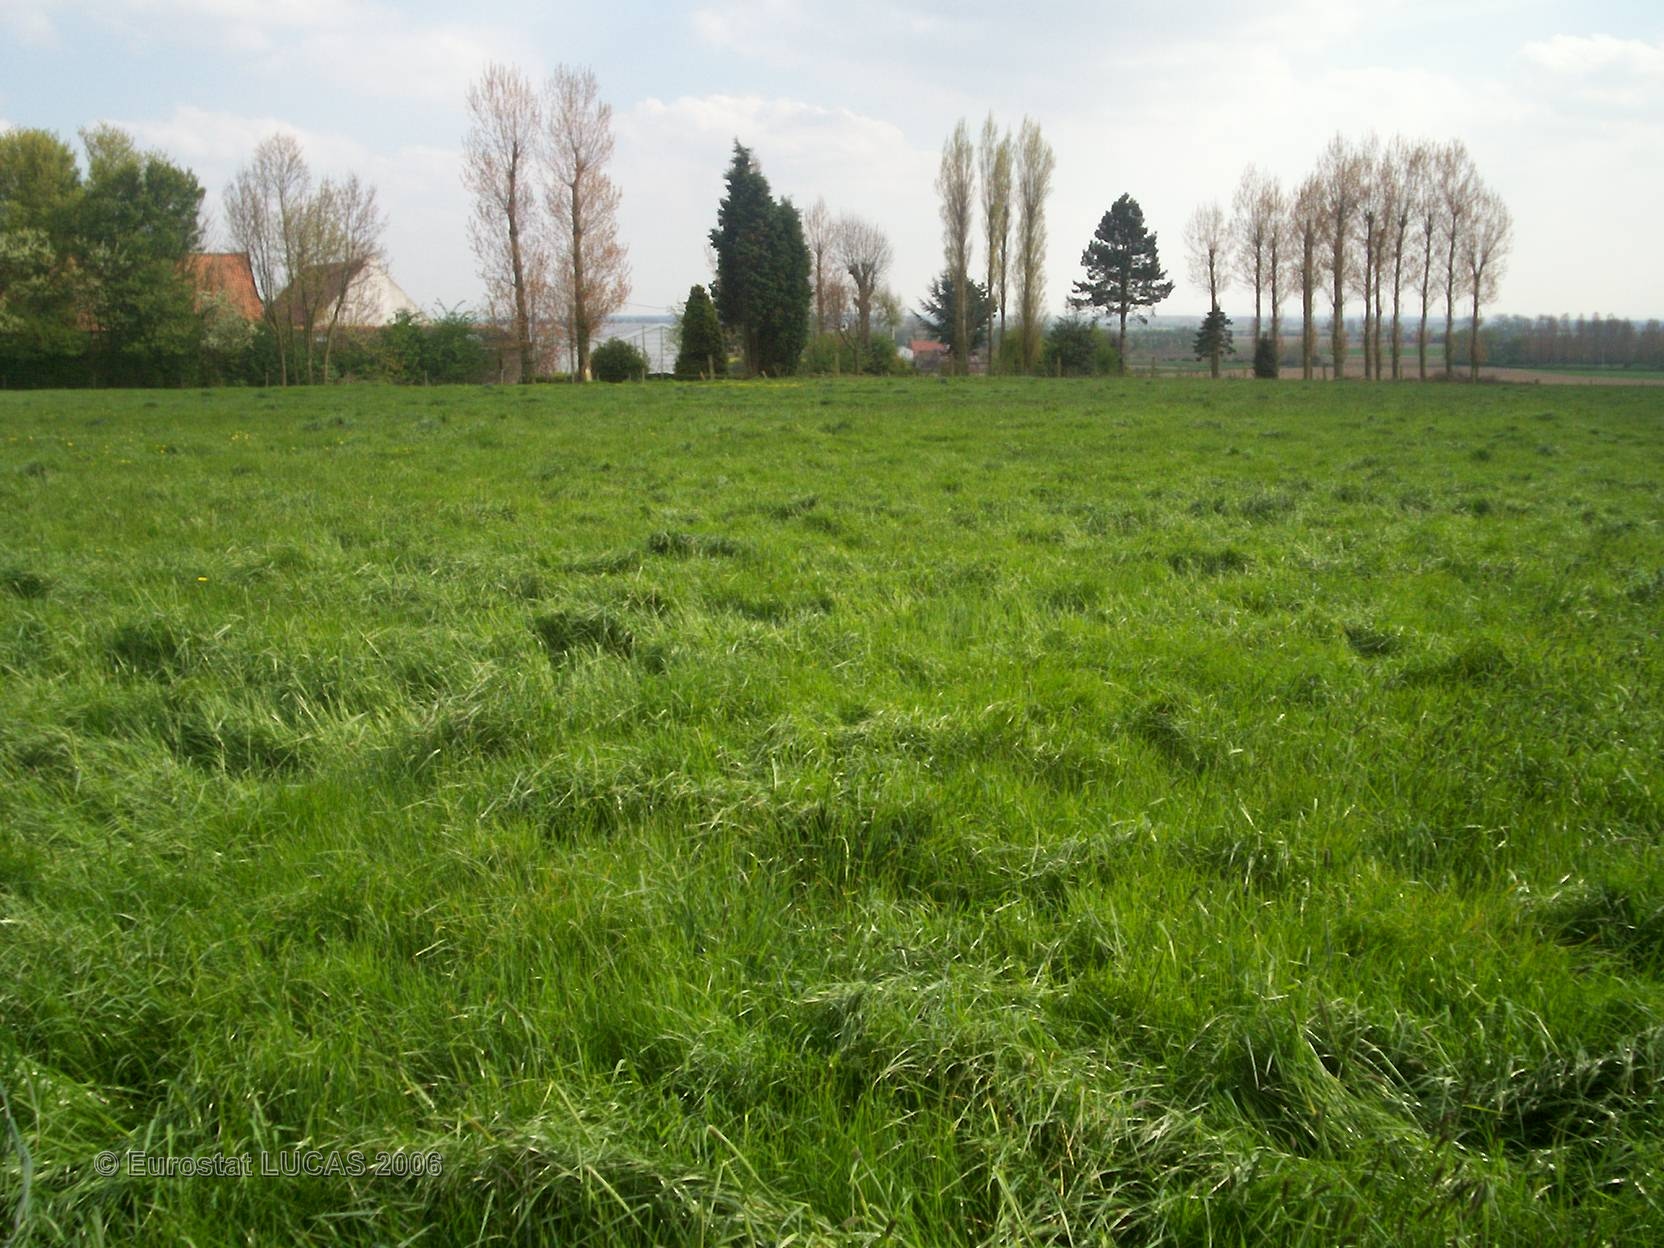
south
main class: Grassland
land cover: Grassland without tree/shrub cover
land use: Agriculture (excluding fallow land and kitchen gardens)
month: May
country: FR
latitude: 50.7724
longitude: 2.5714
